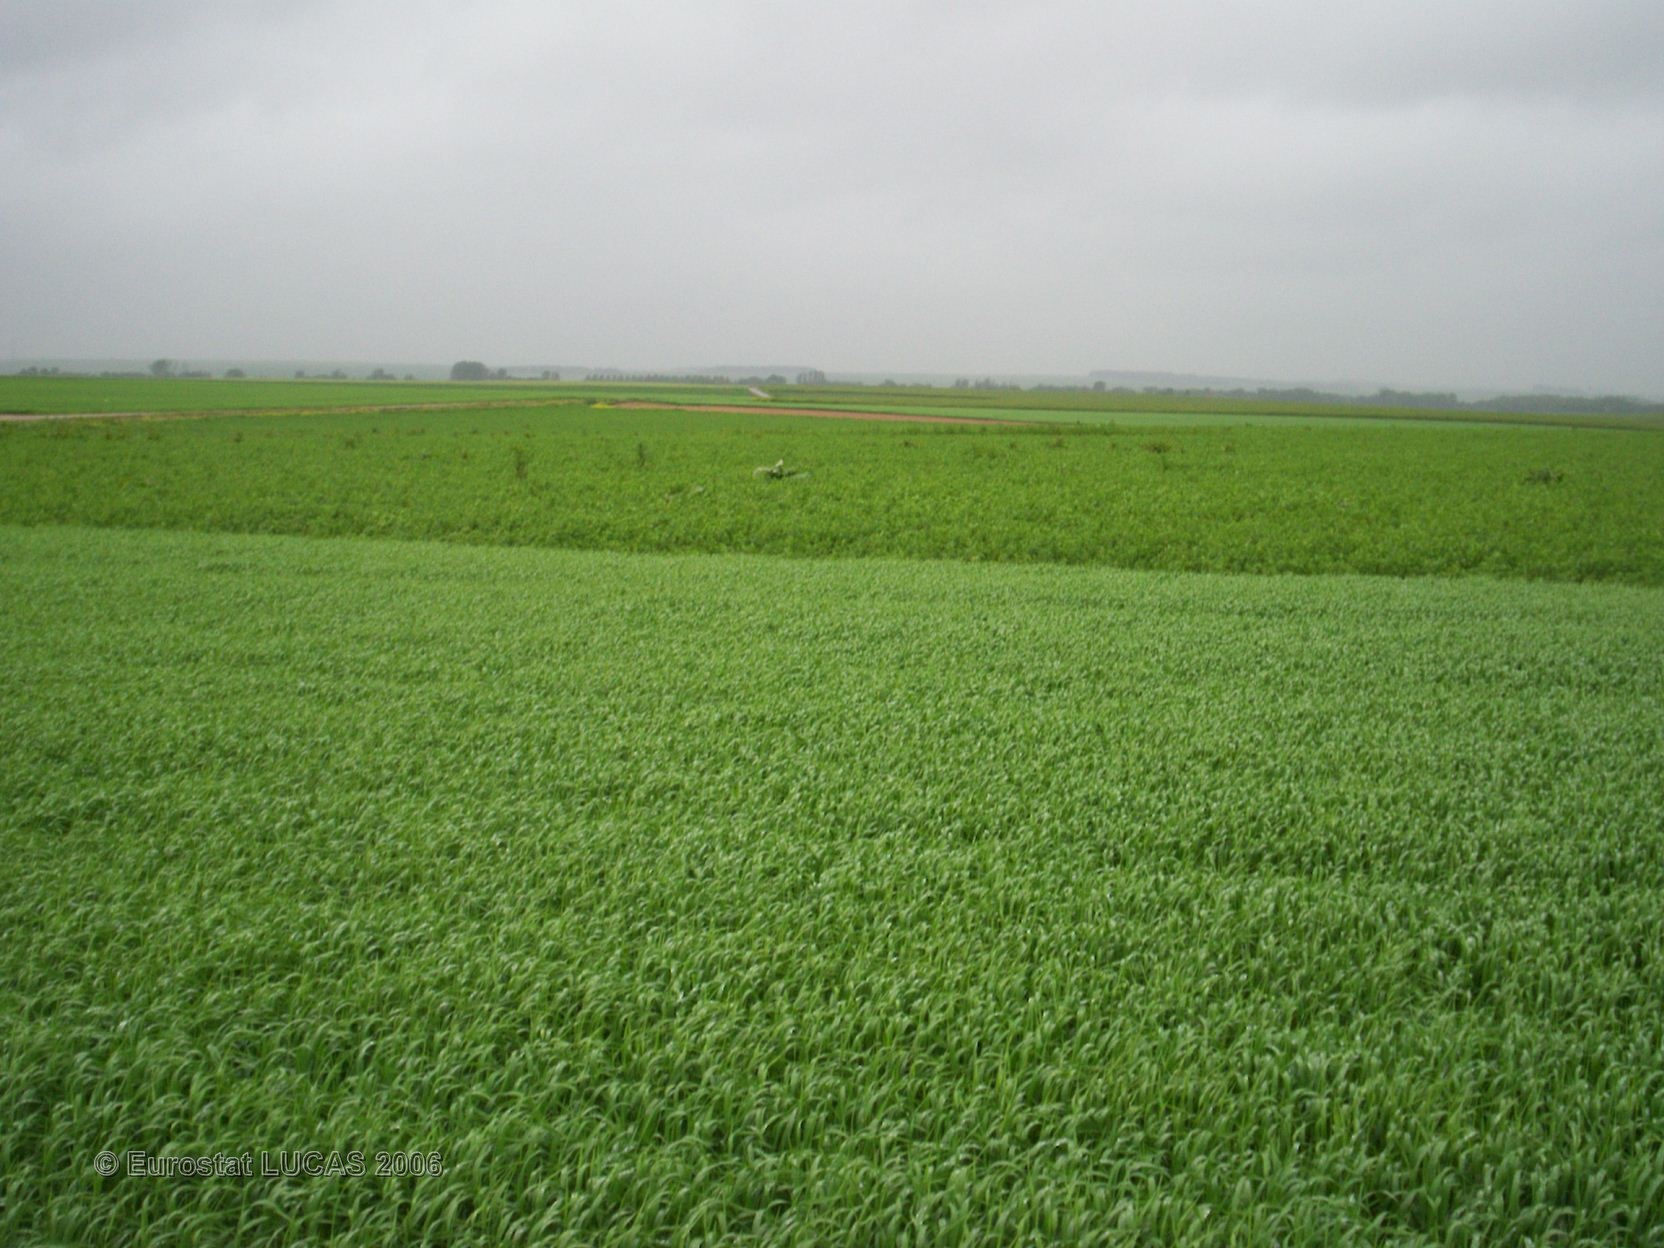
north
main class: Cropland
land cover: Barley
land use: Agriculture (excluding fallow land and kitchen gardens)
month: May
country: FR
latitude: 49.3819
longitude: 4.4450
